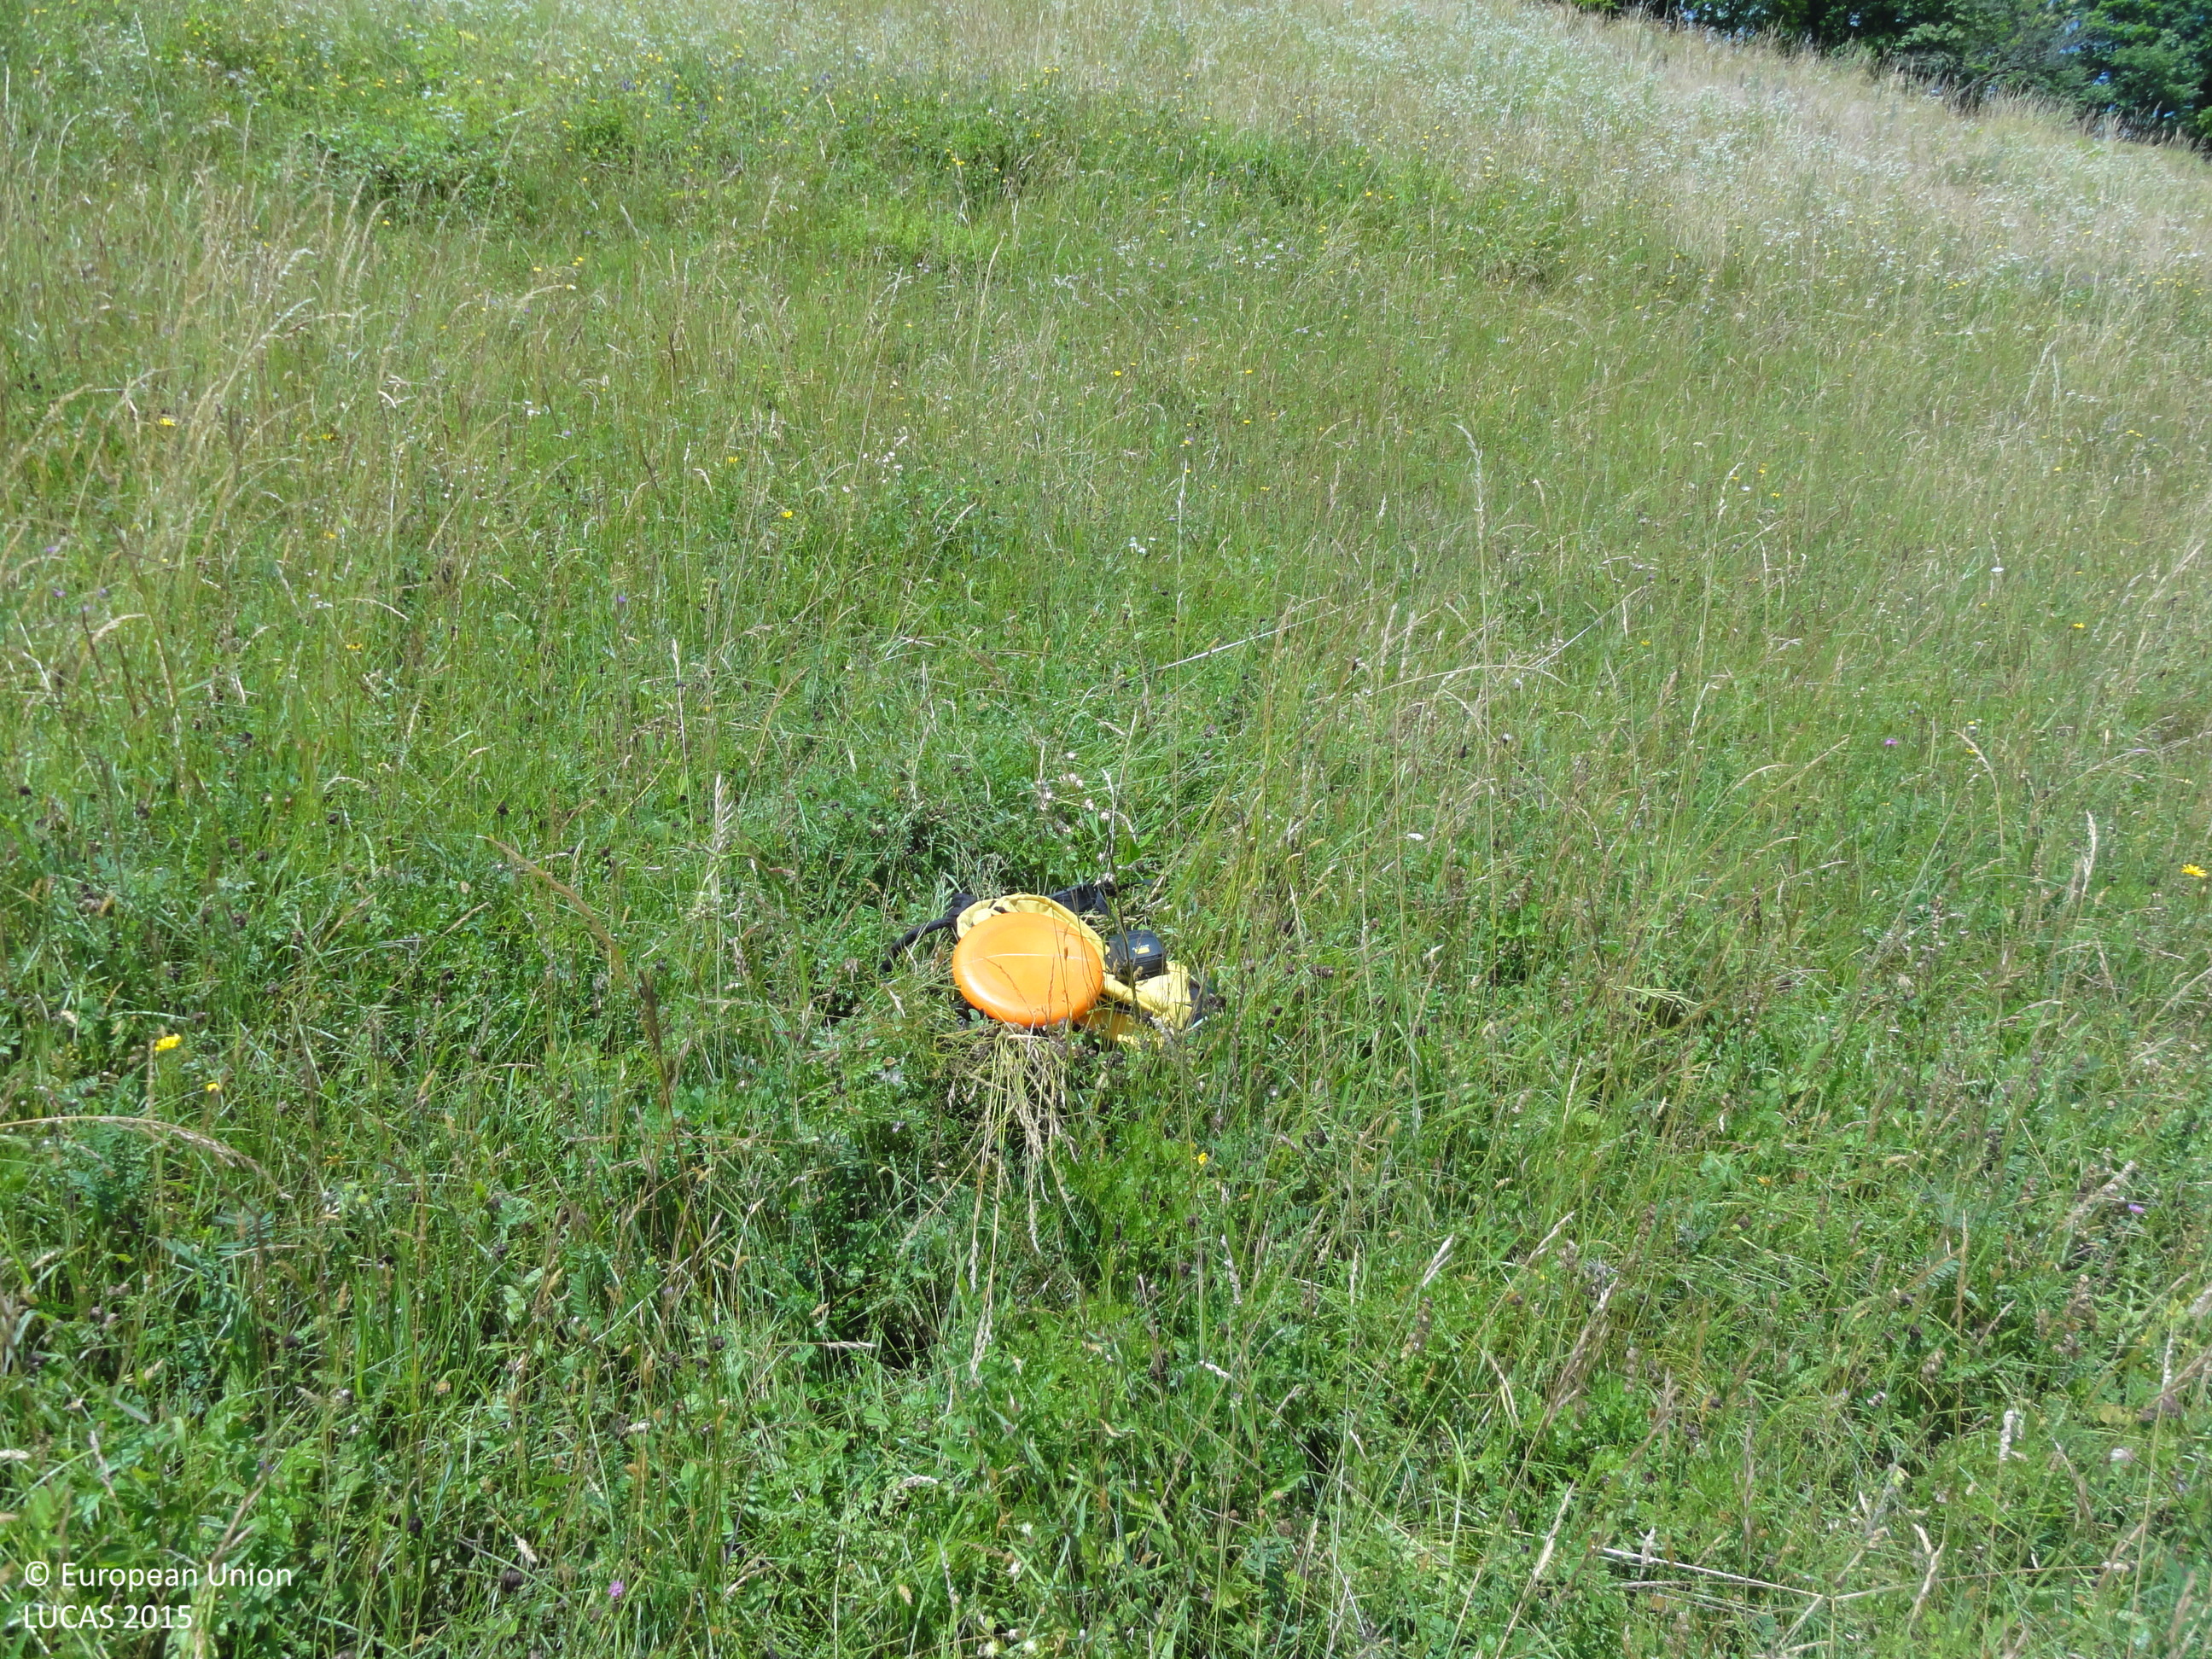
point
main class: Grassland
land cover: Grassland with sparse tree/shrub cover
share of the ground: > 75 %
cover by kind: herbaceous plants 95 %, broadleaved forest trees 5 %
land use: Agriculture (excluding fallow land and kitchen gardens)
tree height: > 5 m
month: June
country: SI
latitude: 46.2897
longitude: 15.6969
